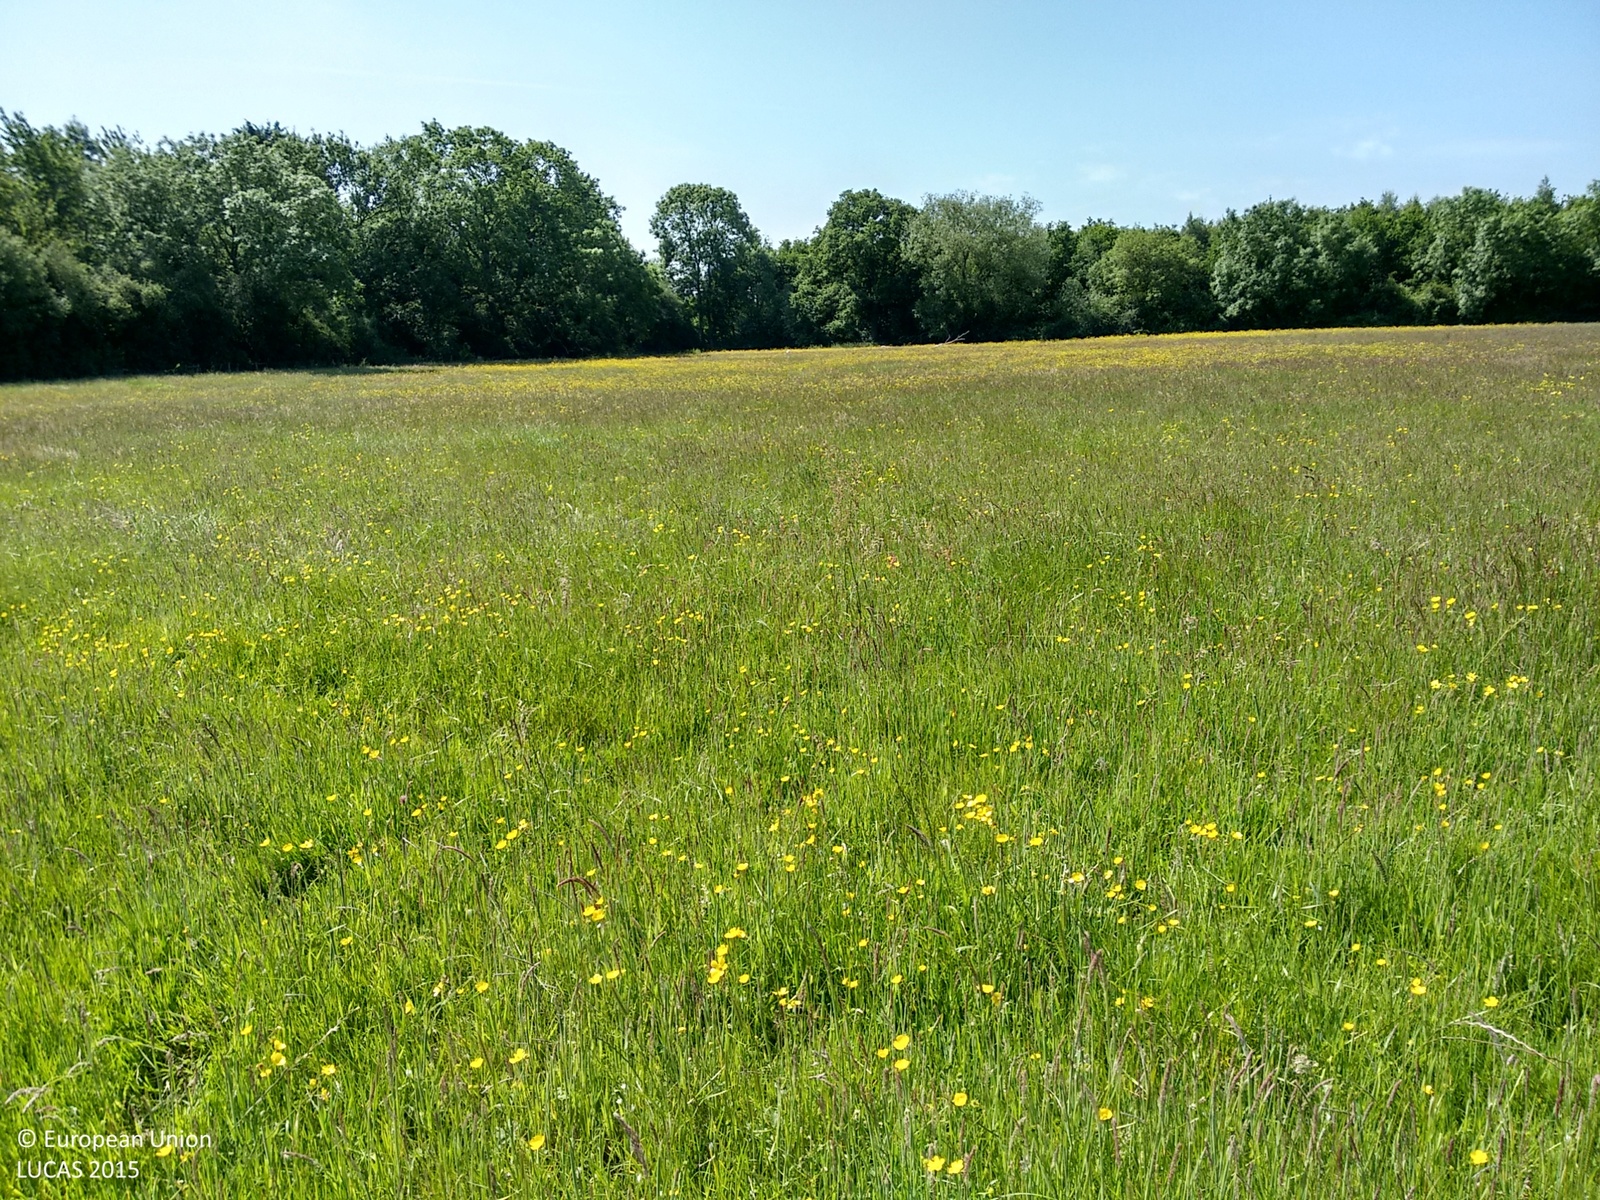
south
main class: Grassland
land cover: Grassland without tree/shrub cover
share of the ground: > 75 %
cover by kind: herbaceous plants 100 %
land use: Agriculture (excluding fallow land and kitchen gardens)
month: June
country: GB
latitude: 52.0272
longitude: -0.8127
